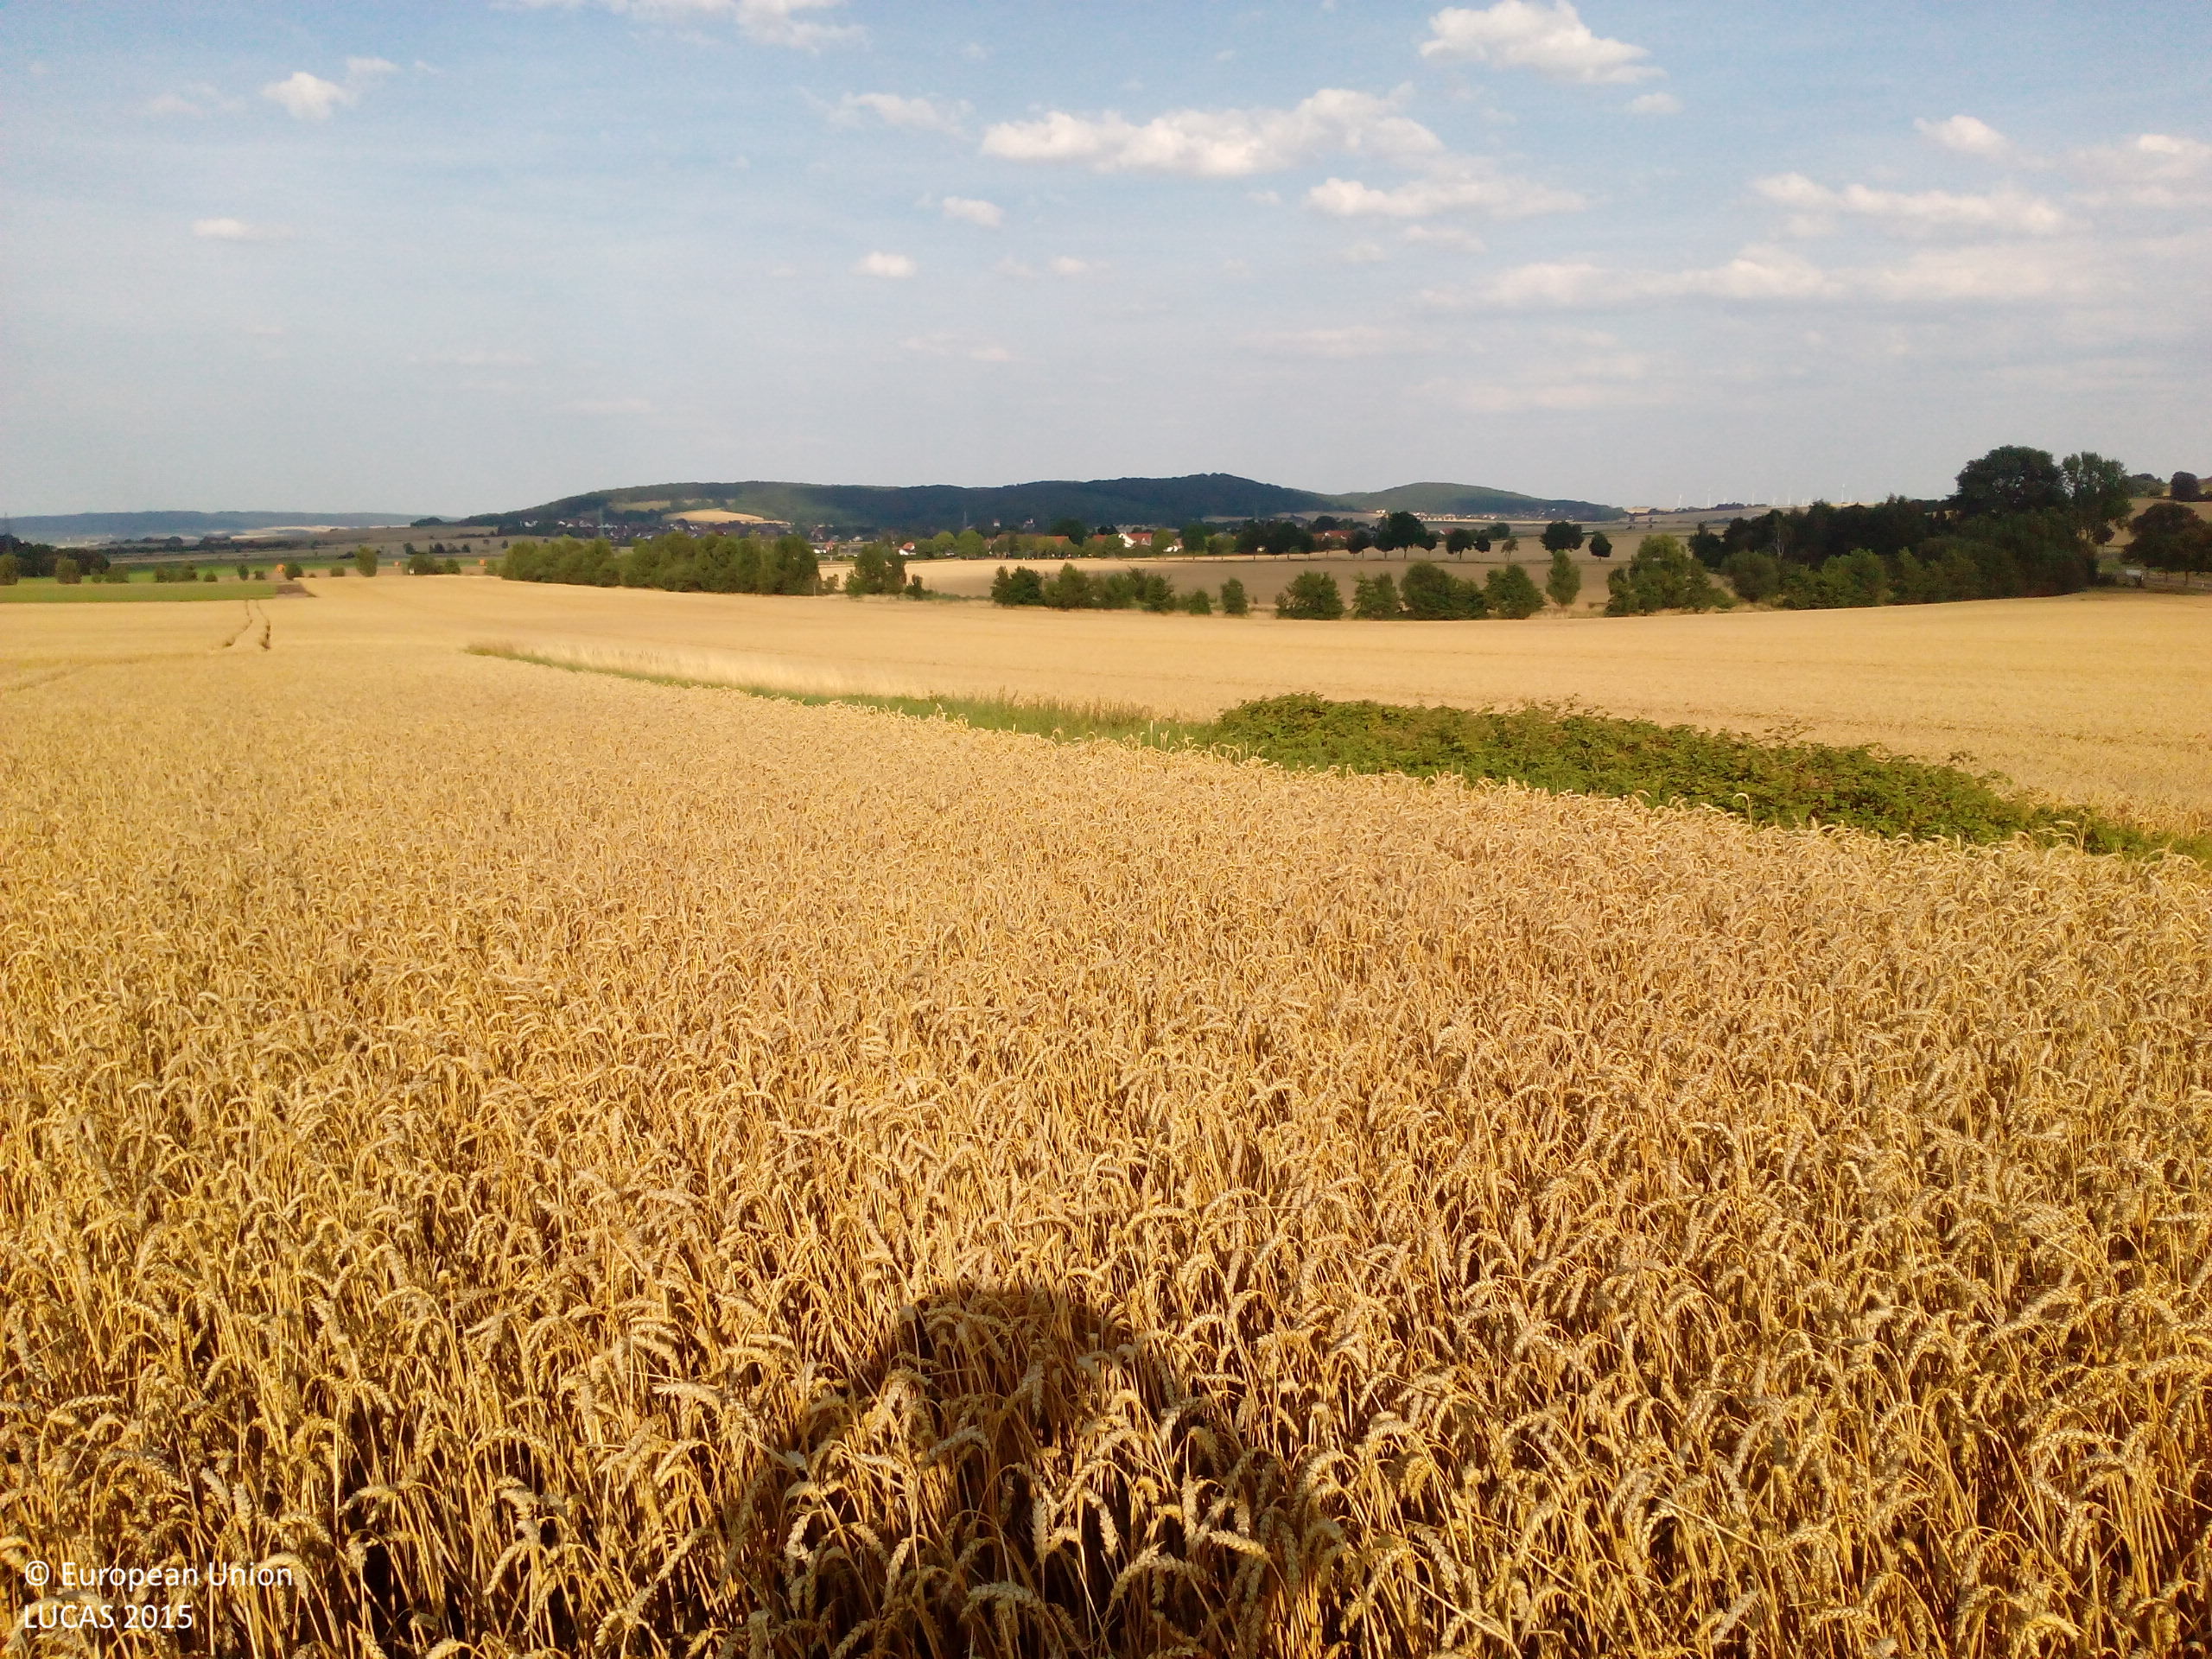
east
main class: Cropland
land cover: Common wheat
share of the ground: > 75 %
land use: Agriculture (excluding fallow land and kitchen gardens)
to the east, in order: Common wheat; Grassland without tree/shrub cover; Common wheat
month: August
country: DE
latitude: 52.1424
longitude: 10.5697
